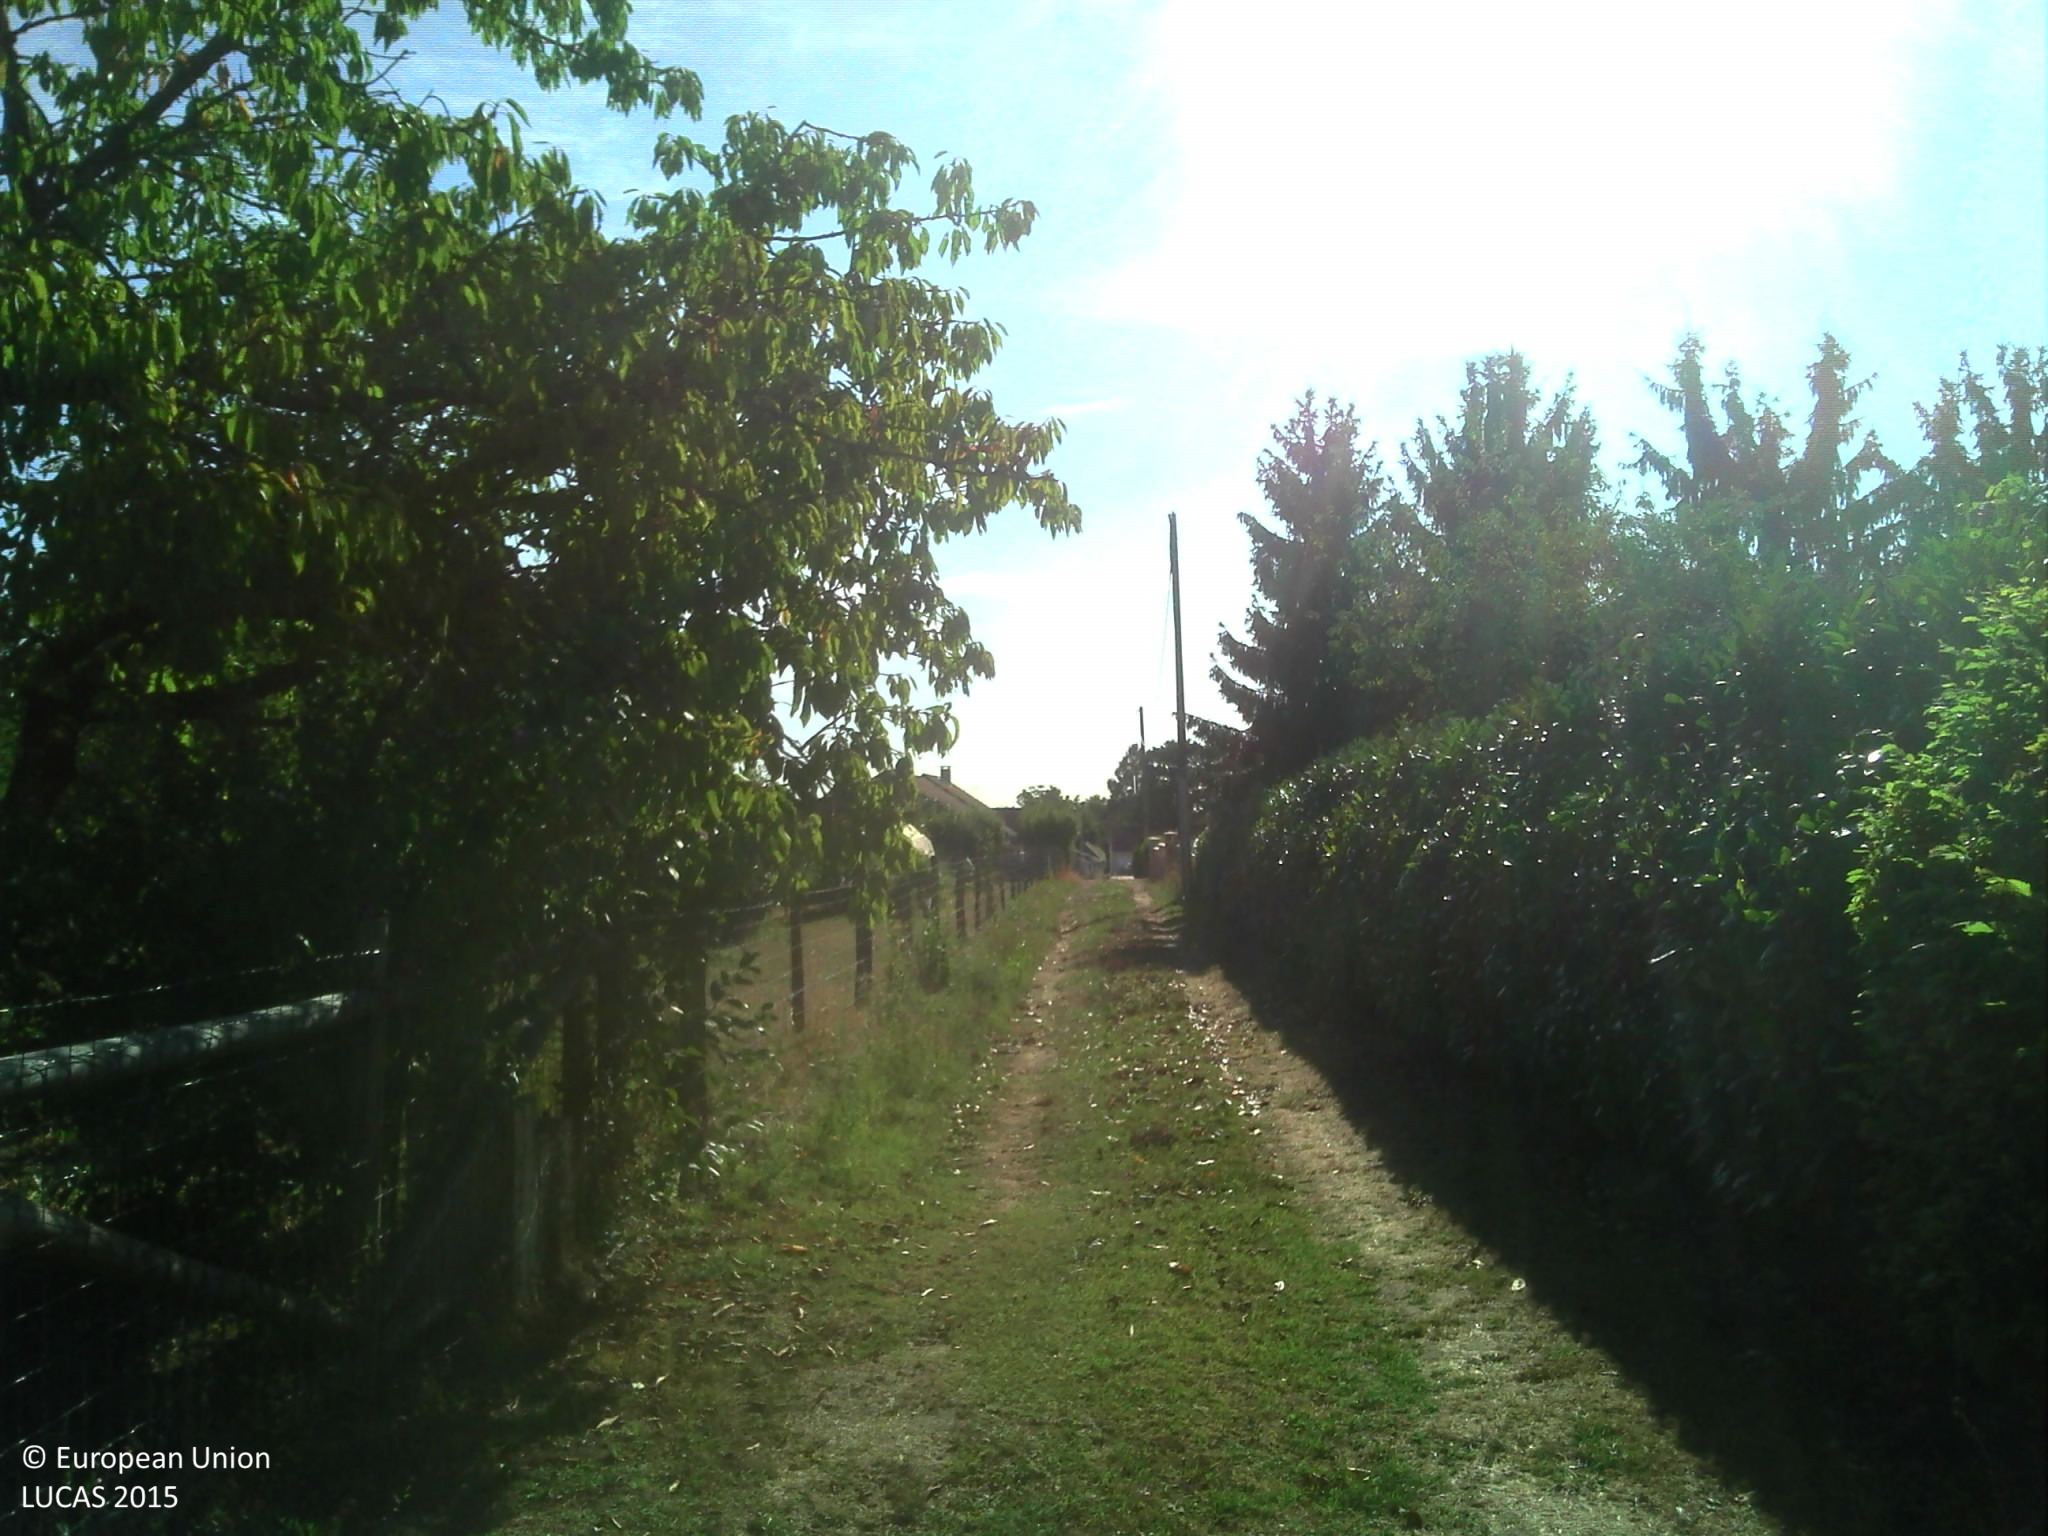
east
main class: Grassland
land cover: Grassland with sparse tree/shrub cover
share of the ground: > 75 %
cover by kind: herbaceous plants 95 %, broadleaved forest trees 5 %
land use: Residential
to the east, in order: Tracks; Managed hedges; Grassland with sparse tree/shrub cover; Artificial constructions in urban areas
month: July
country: FR
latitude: 46.7328
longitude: 4.8585
